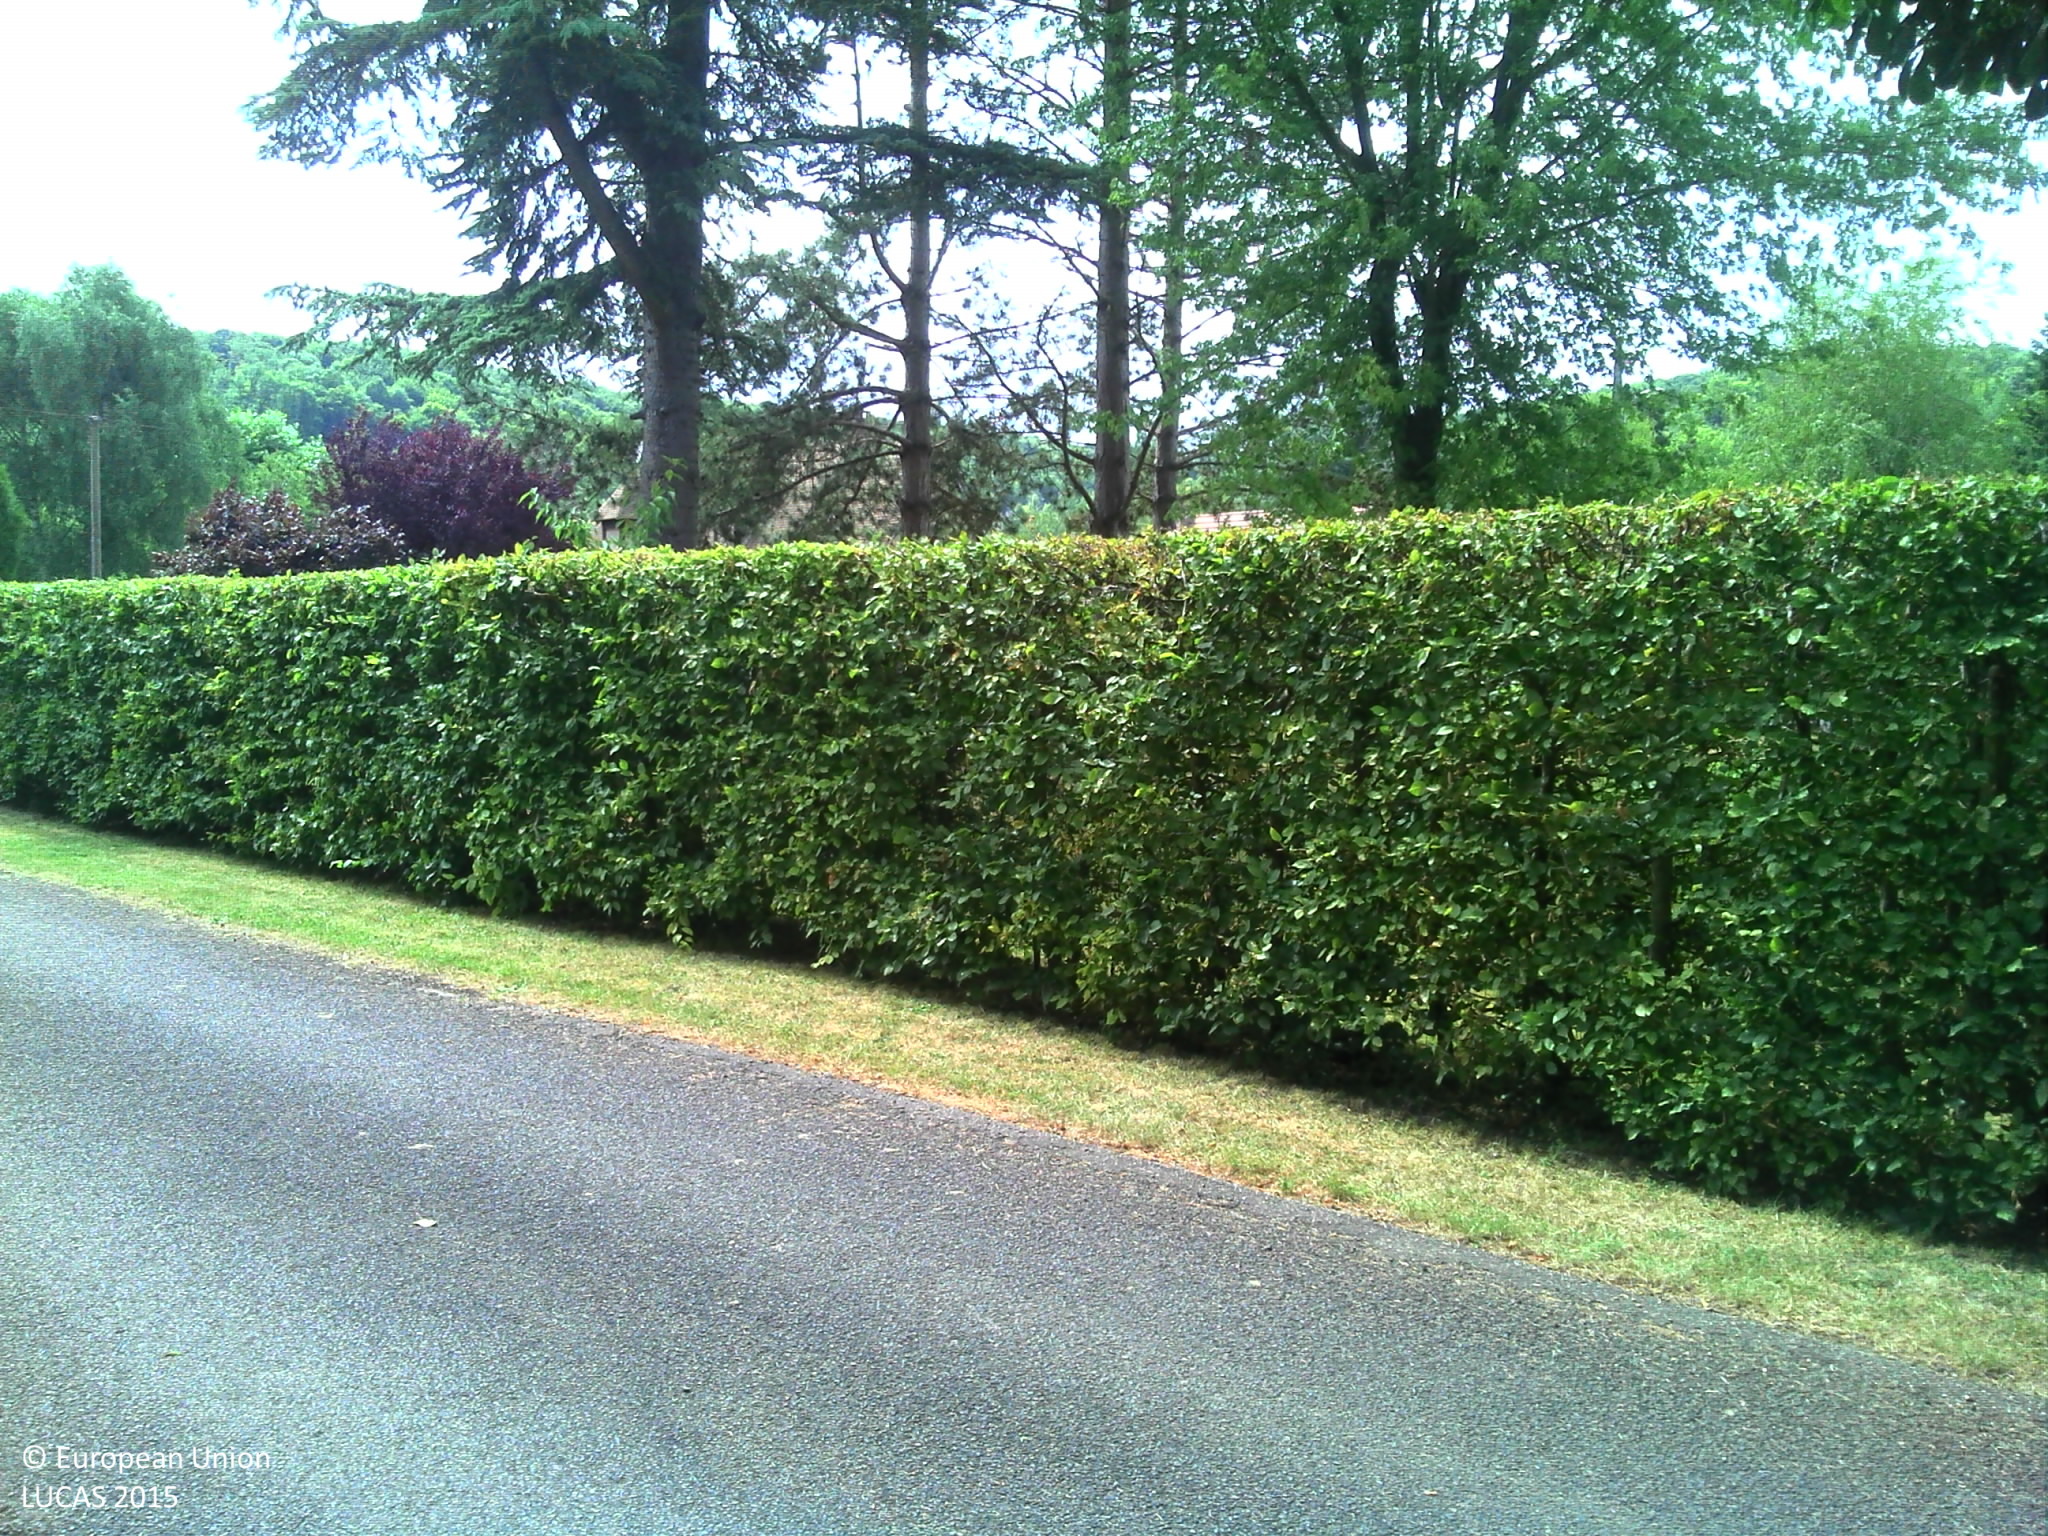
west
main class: Grassland
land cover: Grassland without tree/shrub cover
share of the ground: > 75 %
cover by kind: herbaceous plants 100 %
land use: Residential
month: June
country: FR
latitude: 49.0724
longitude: 1.2882
